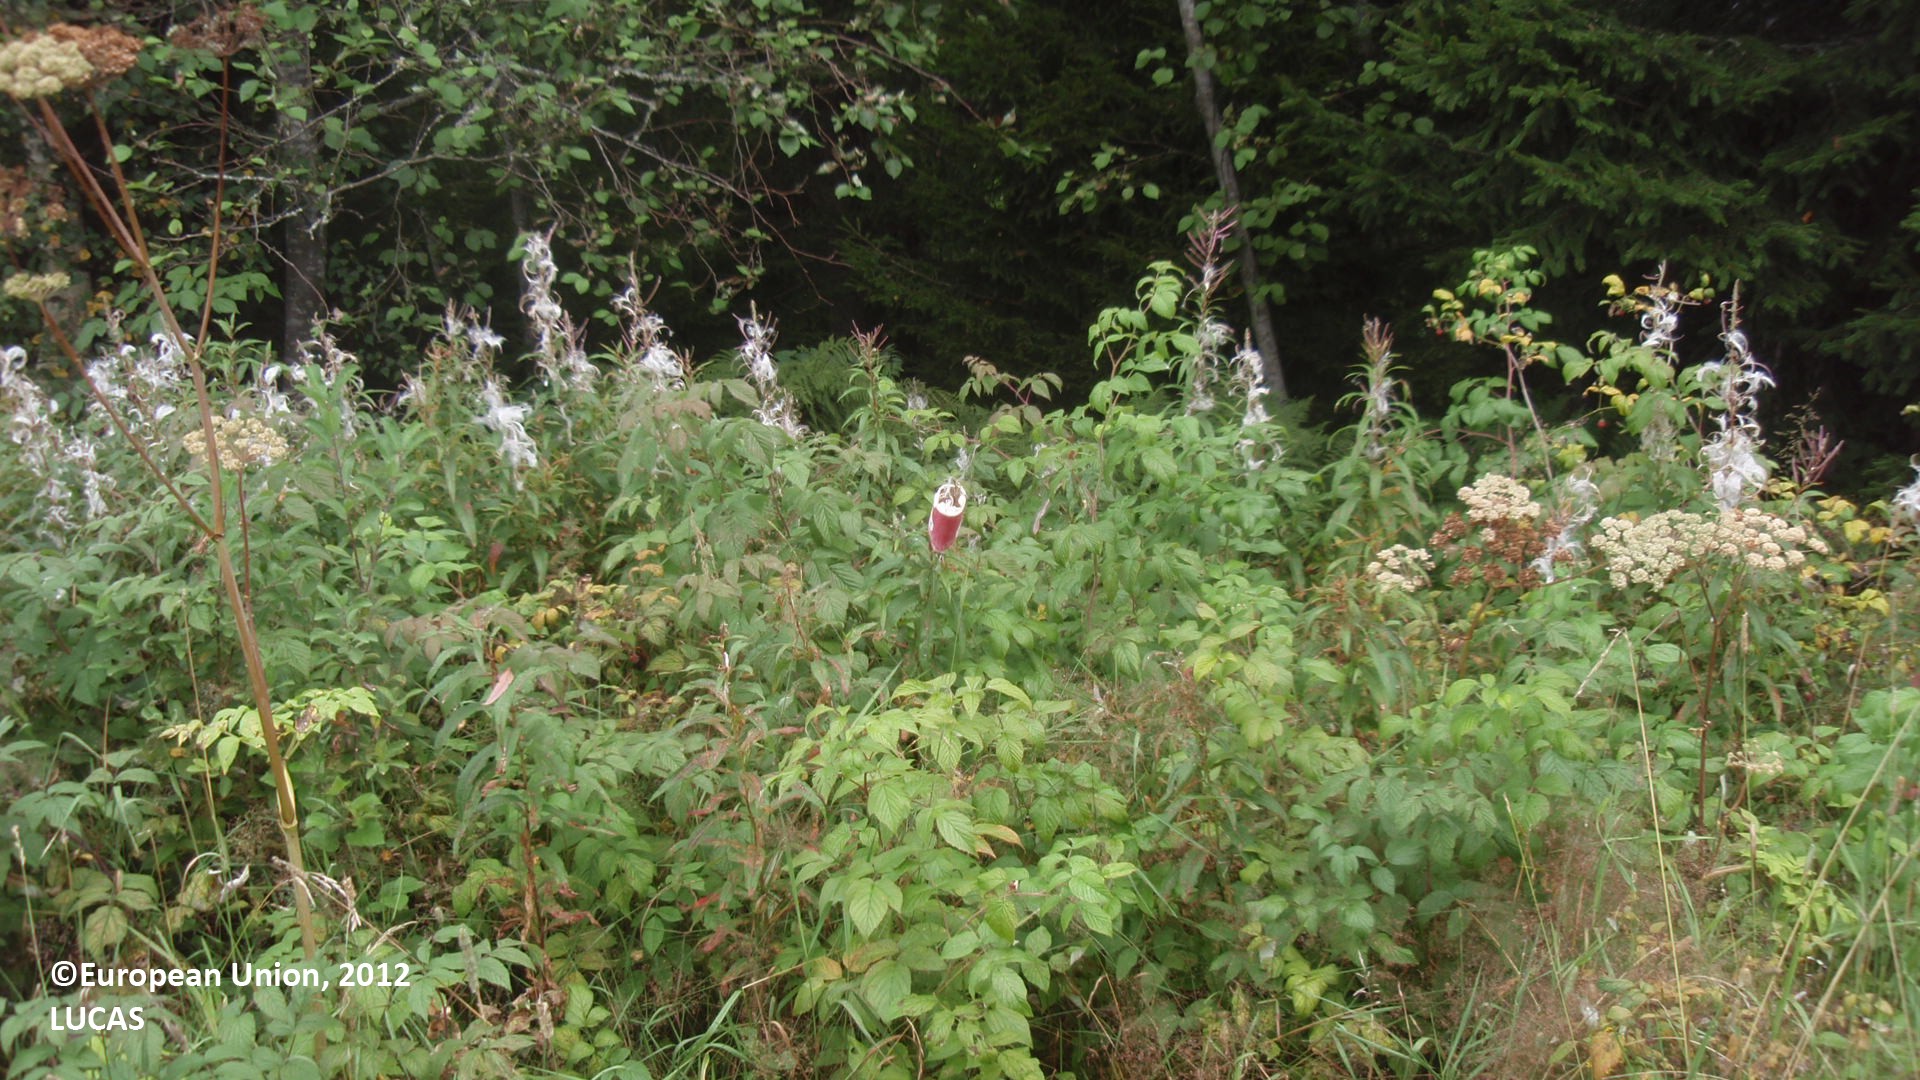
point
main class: Shrubland
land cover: Shrubland with sparse tree cover
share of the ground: > 75 %
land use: Agriculture (excluding fallow land and kitchen gardens)
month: August
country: FI
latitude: 60.8811
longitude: 27.4048
